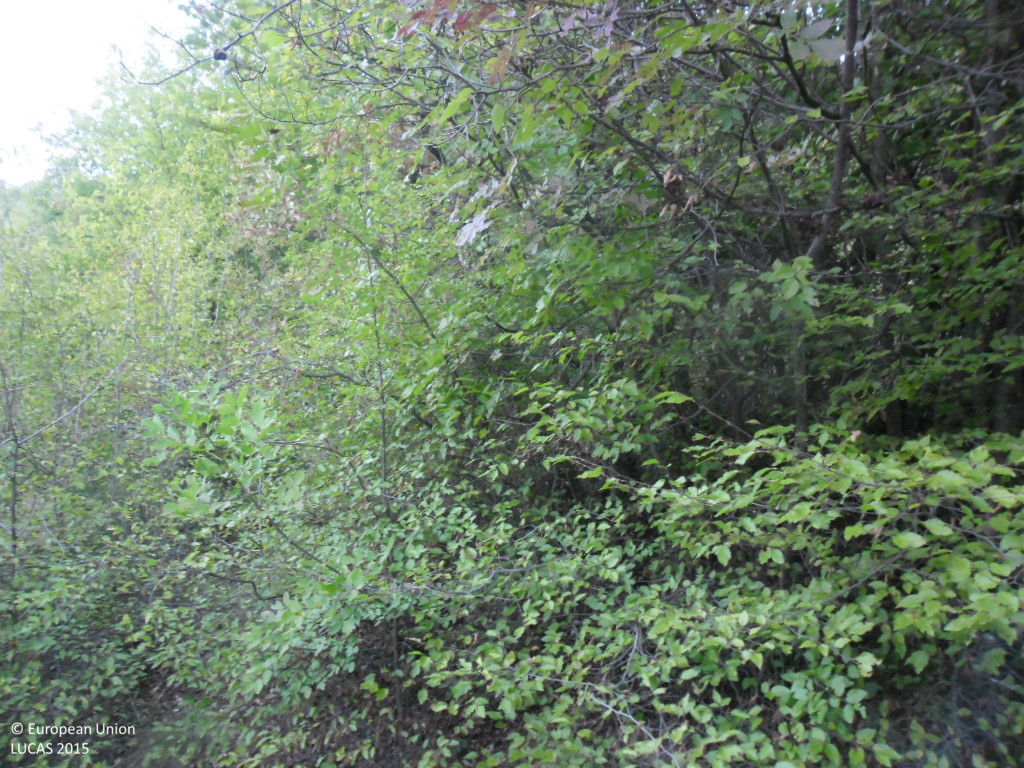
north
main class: Woodland
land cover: Broadleaved woodland
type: mesophytic deciduous forest
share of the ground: > 75 %
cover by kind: broadleaved forest trees 75 %, herbaceous plants 15 %, shrubs 5 %, unconsolidated bare surface 5 %
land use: Forestry
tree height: < 5 m
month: October
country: BG
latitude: 42.0692
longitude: 22.9916
